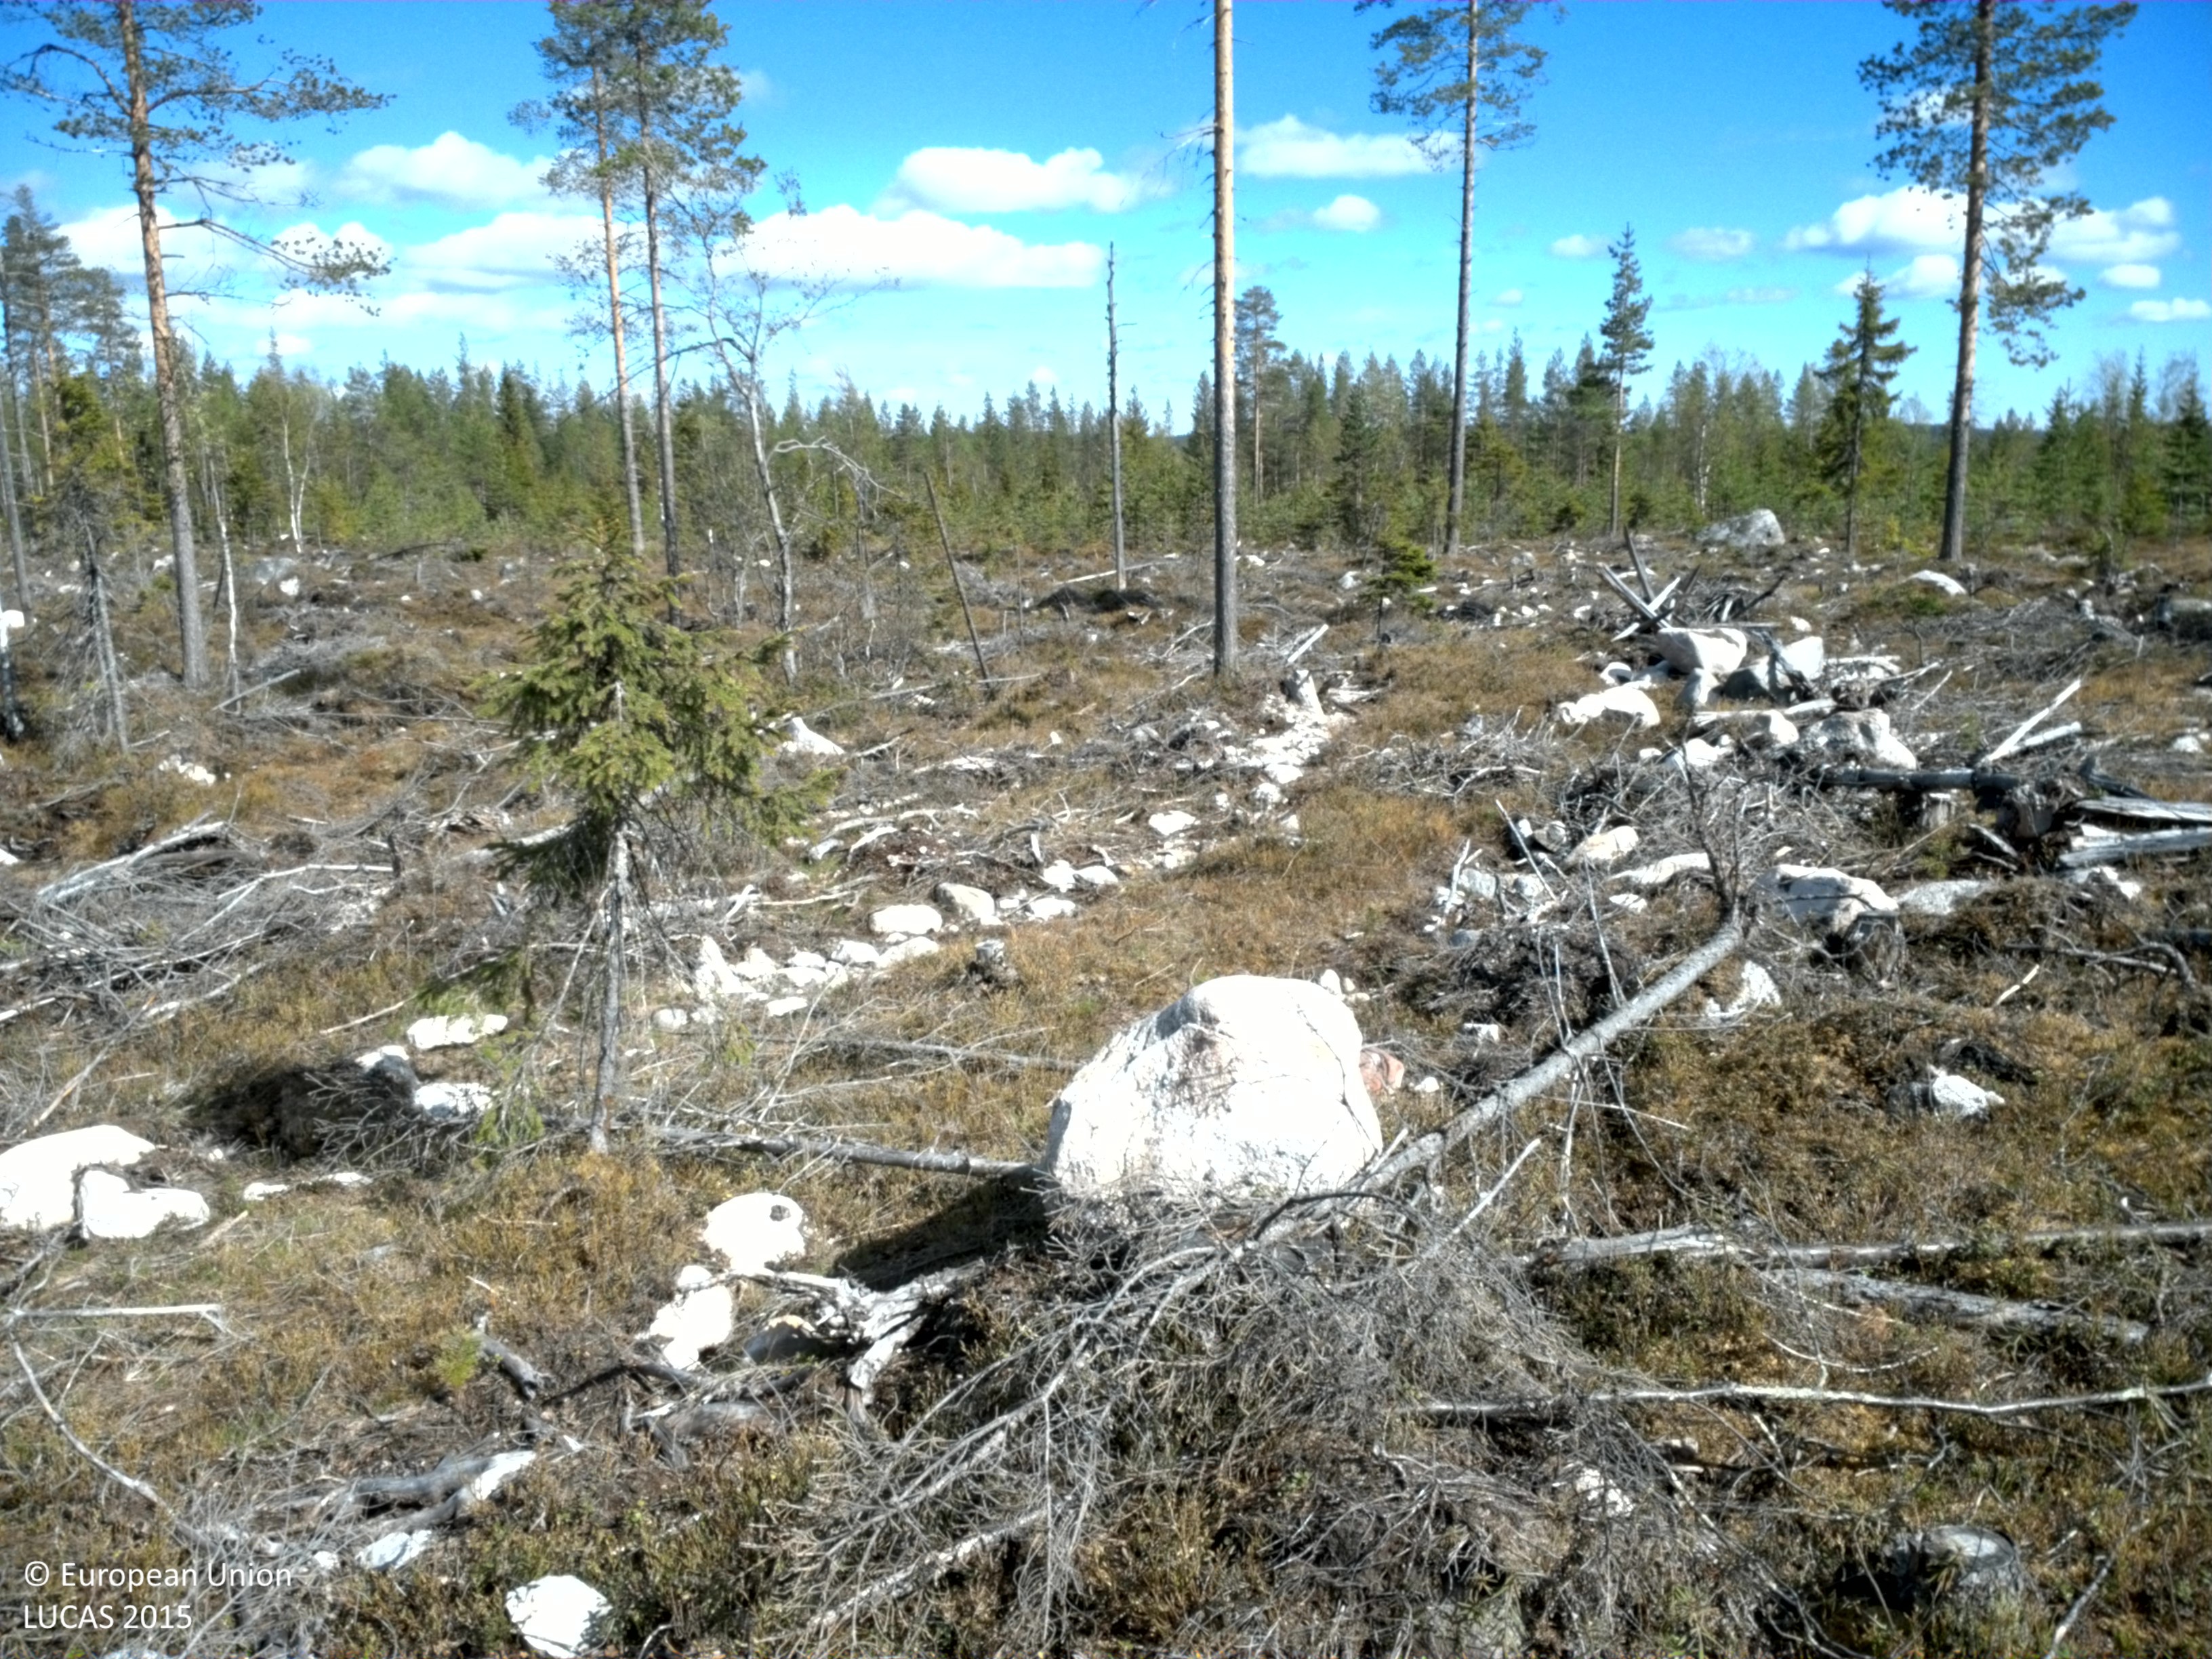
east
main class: Shrubland
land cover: Shrubland with sparse tree cover
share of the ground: > 75 %
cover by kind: shrubs 85 %, unconsolidated bare surface 10 %, coniferous forest trees 5 %
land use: Forestry
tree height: < 5 m
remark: Clear cut
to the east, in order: Shrubland with sparse tree cover; Pine dominated coniferous woodland
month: May
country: SE
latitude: 66.1267
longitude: 23.1597
